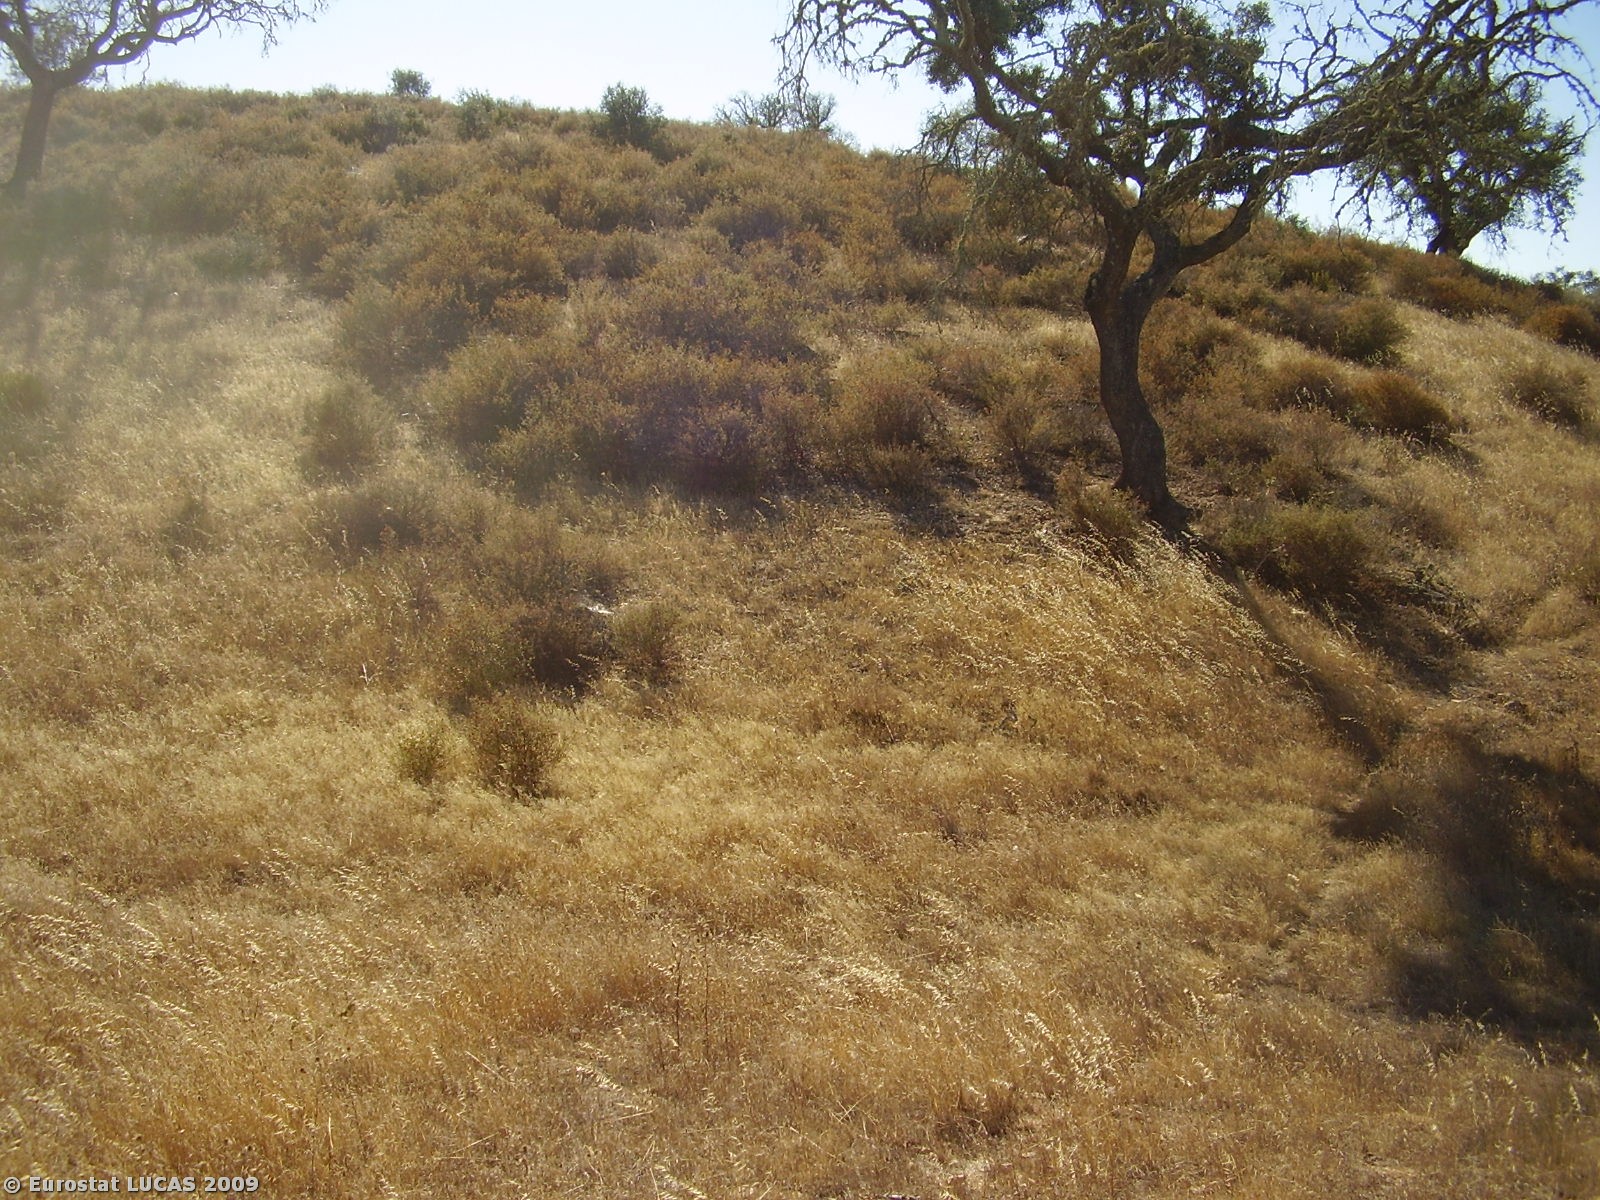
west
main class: Woodland
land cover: Broadleaved woodland
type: broadleaved evergreen forest
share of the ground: 10 - 25 %
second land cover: Spontaneously vegetated surfaces
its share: 50 - 75 %
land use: Forestry
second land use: Fallow land
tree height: > 5 m
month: July
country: PT
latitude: 37.8481
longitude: -7.5063
